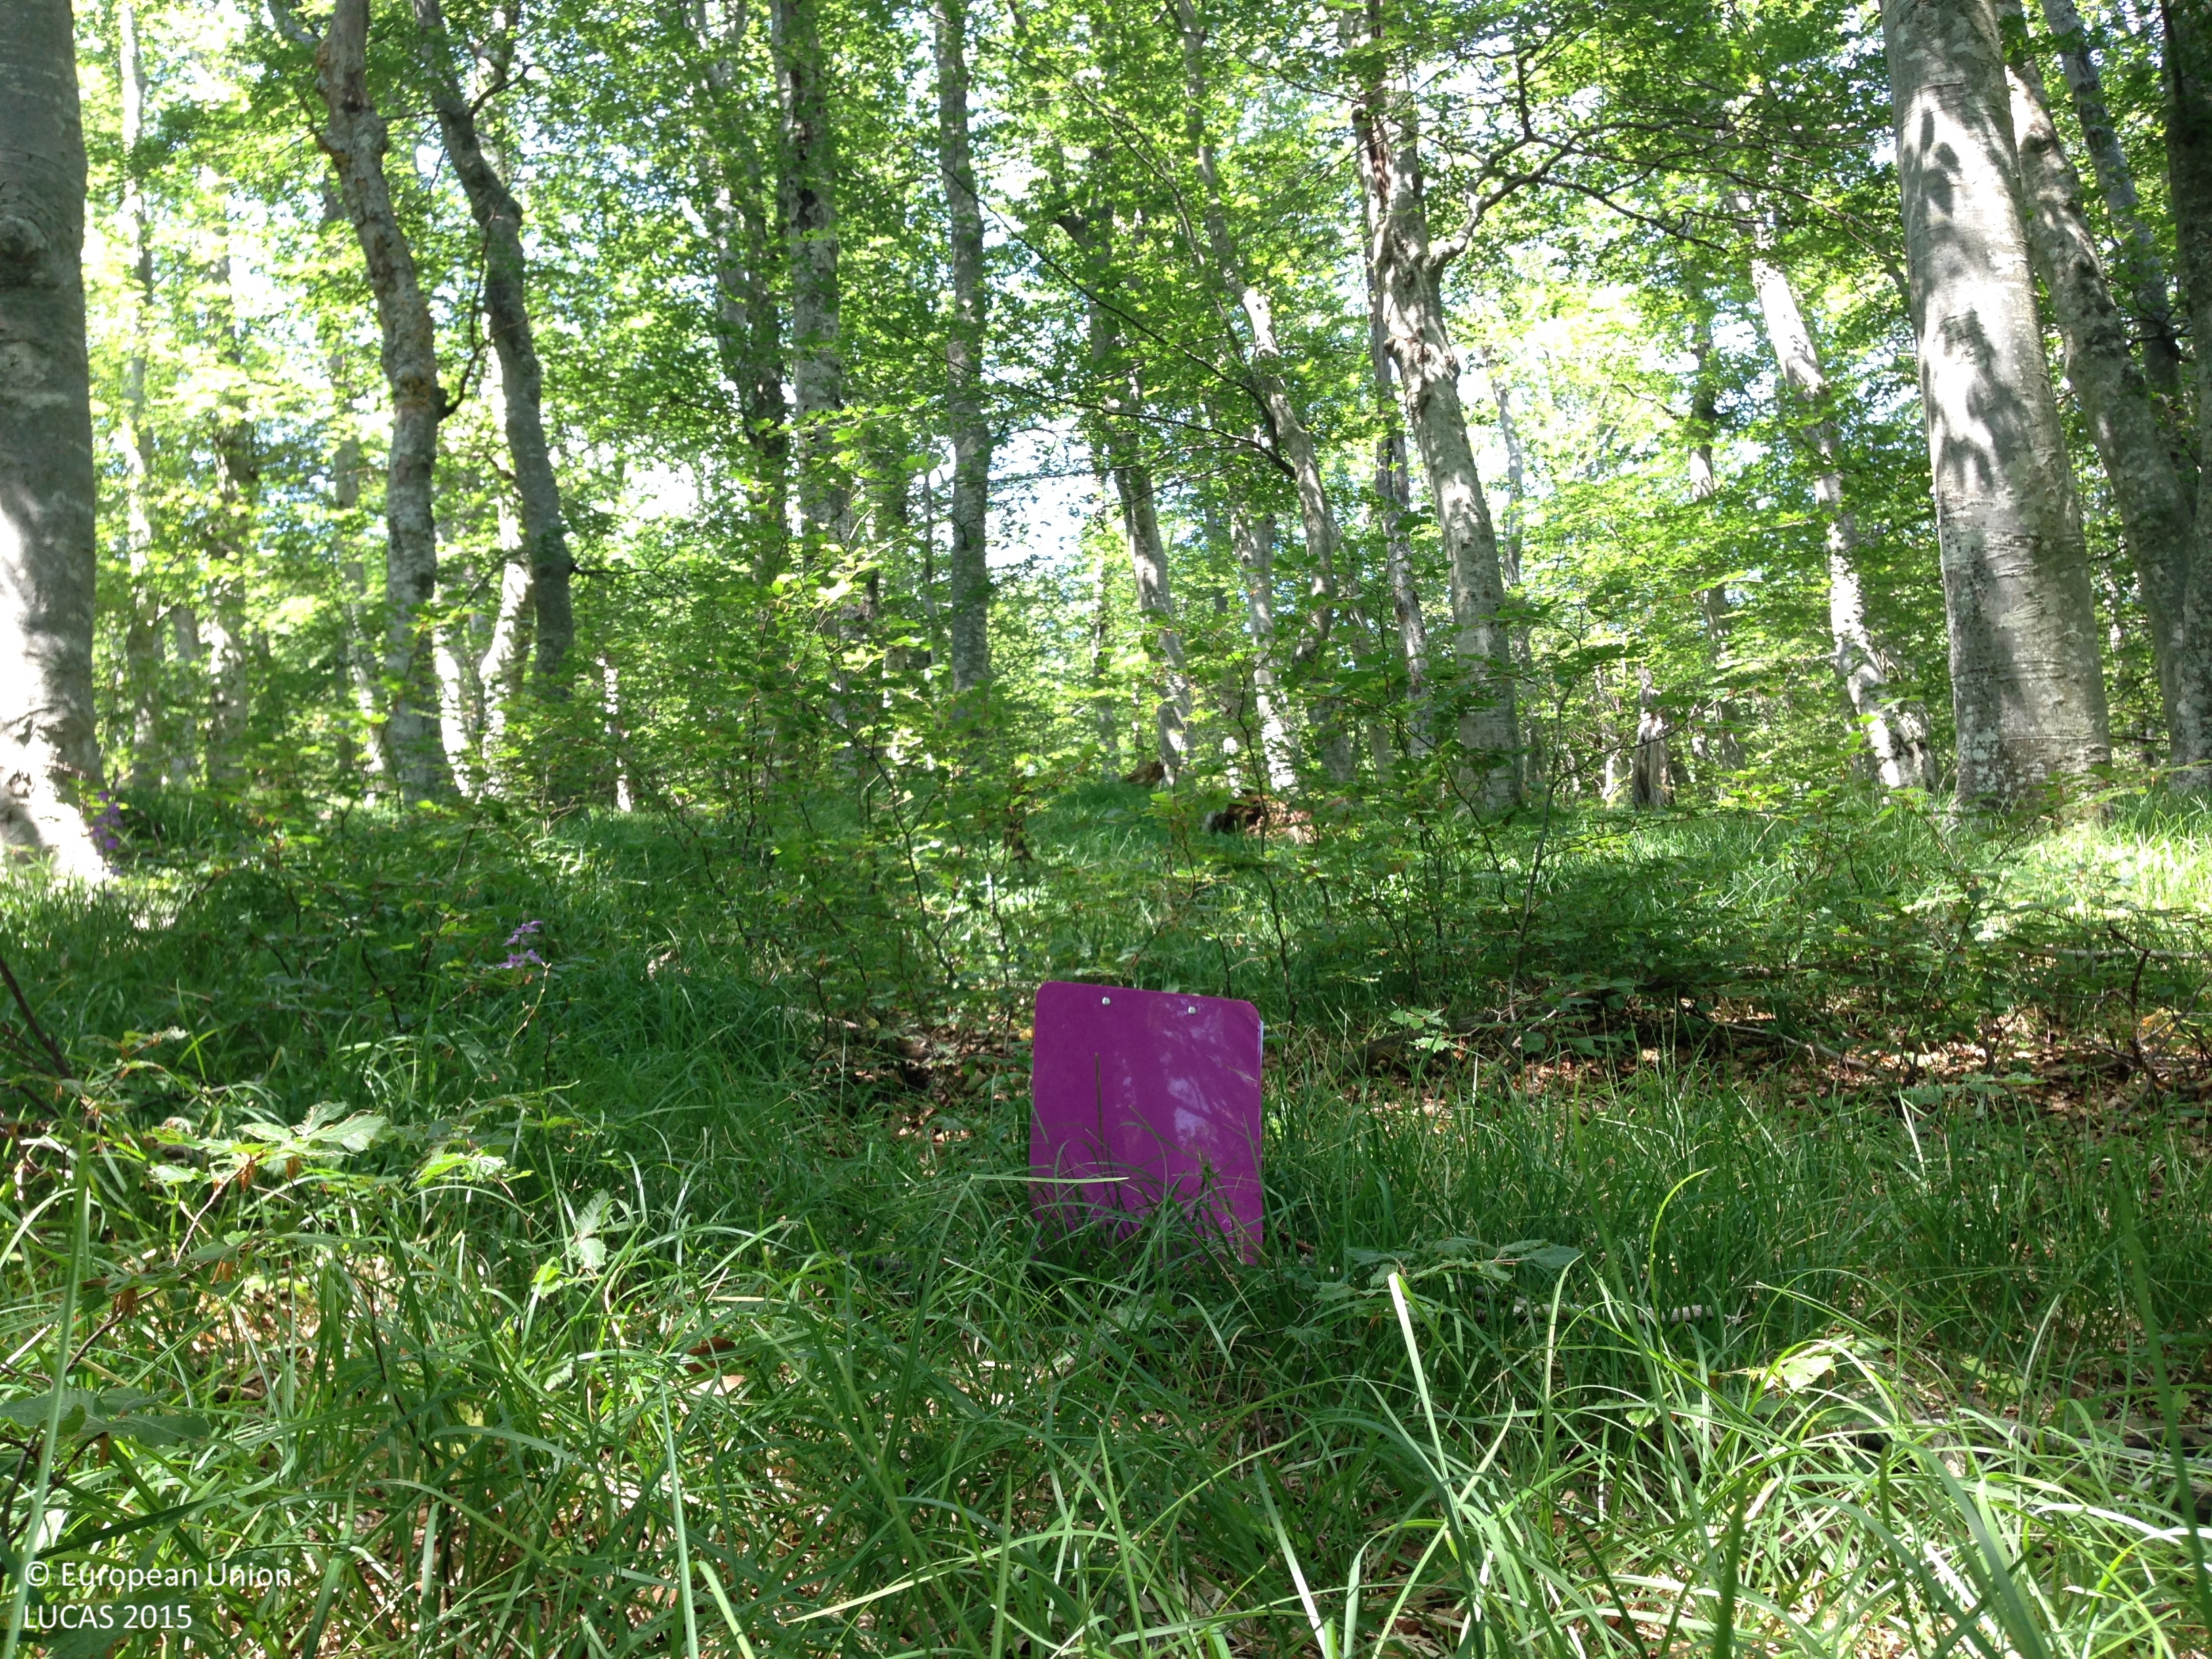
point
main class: Woodland
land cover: Broadleaved woodland
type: mountainous beech forest
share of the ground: > 75 %
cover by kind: broadleaved forest trees 75 %, herbaceous plants 15 %, shrubs 5 %, lichens and mosses 5 %
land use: Forestry
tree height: > 5 m
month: July
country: HR
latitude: 44.5291
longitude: 15.1649
